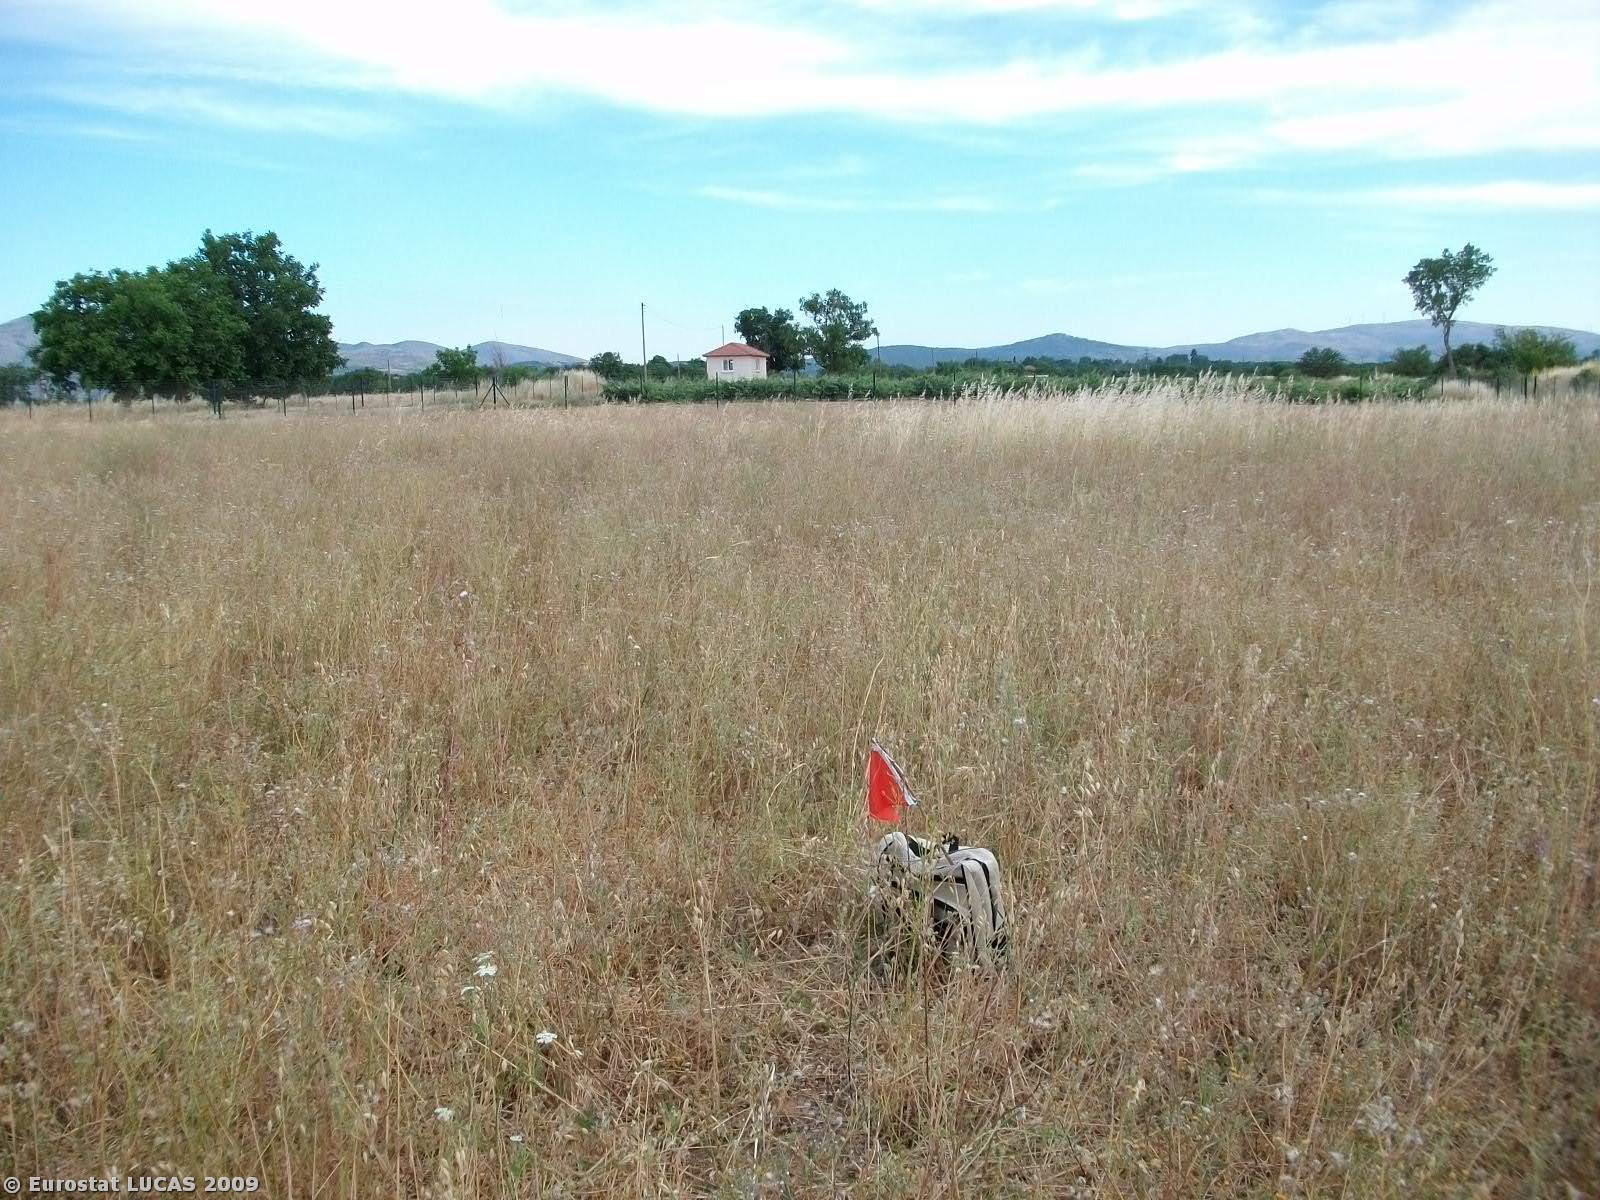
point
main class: Grassland
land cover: Spontaneously vegetated surfaces
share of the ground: > 75 %
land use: Fallow land
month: June
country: GR
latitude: 37.4778
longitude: 22.4347
